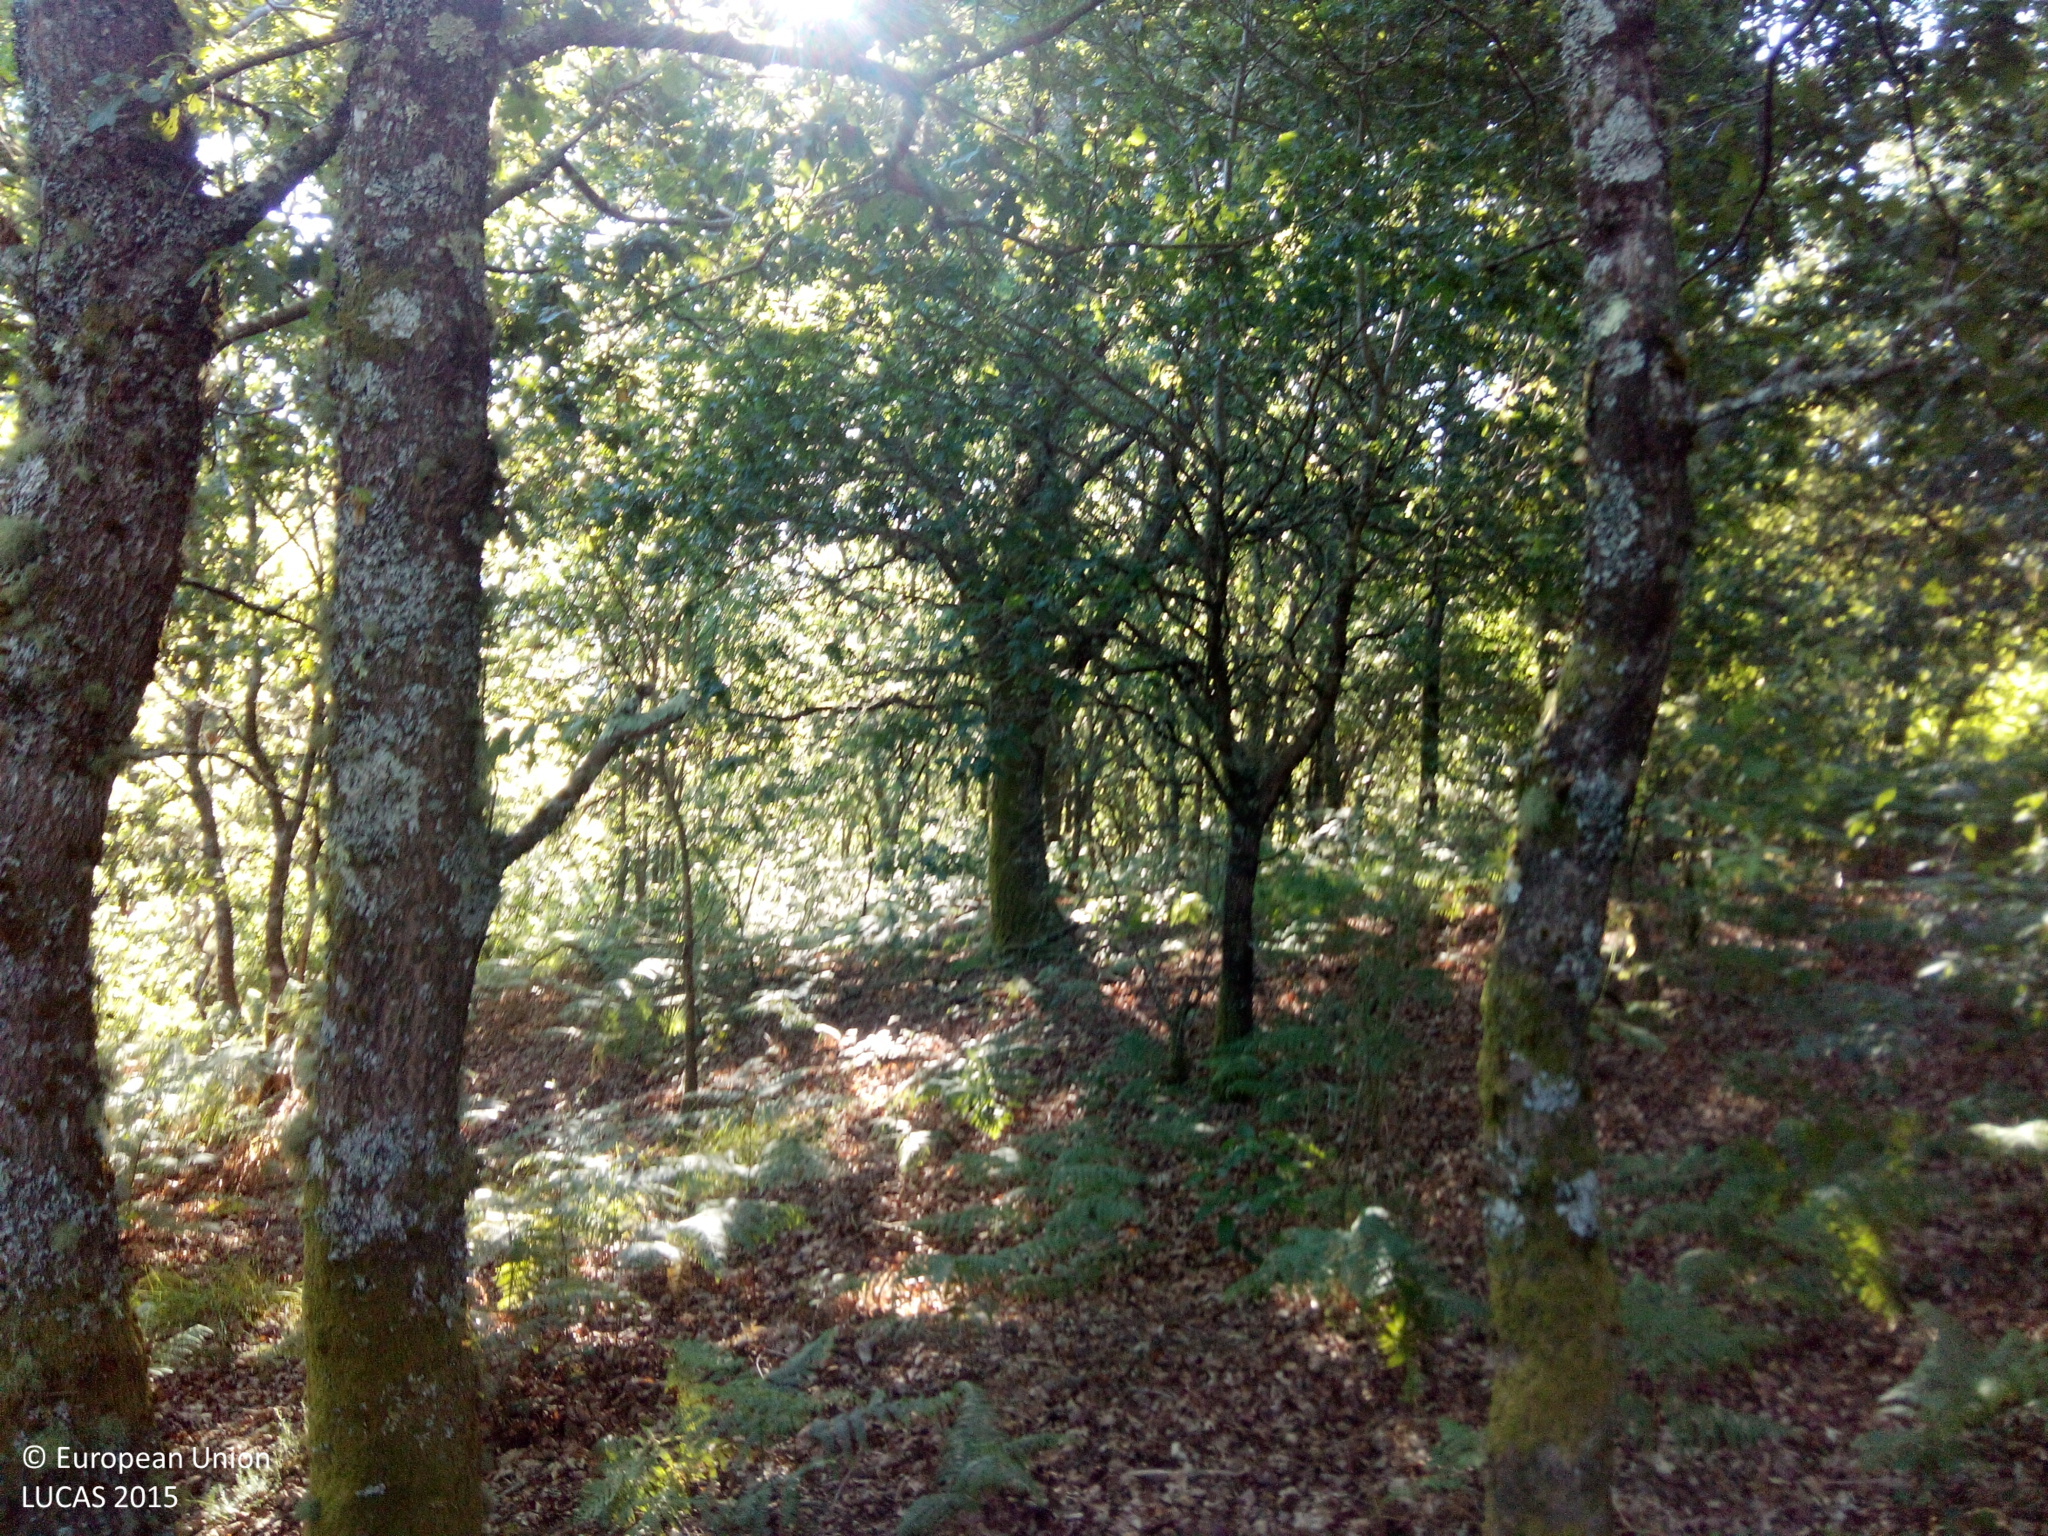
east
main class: Woodland
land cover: Broadleaved woodland
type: acidophilous oak and oak-birch forest
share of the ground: > 75 %
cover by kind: broadleaved forest trees 75 %, herbaceous plants 15 %, shrubs 10 %
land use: Forestry
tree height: > 5 m
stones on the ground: < 10 %
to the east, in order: Broadleaved woodland; Grassland with sparse tree/shrub cover; Artificial constructions; Tracks; Pine dominated coniferous woodland; Broadleaved woodland
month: June
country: ES
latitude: 42.5230
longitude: -8.3911
